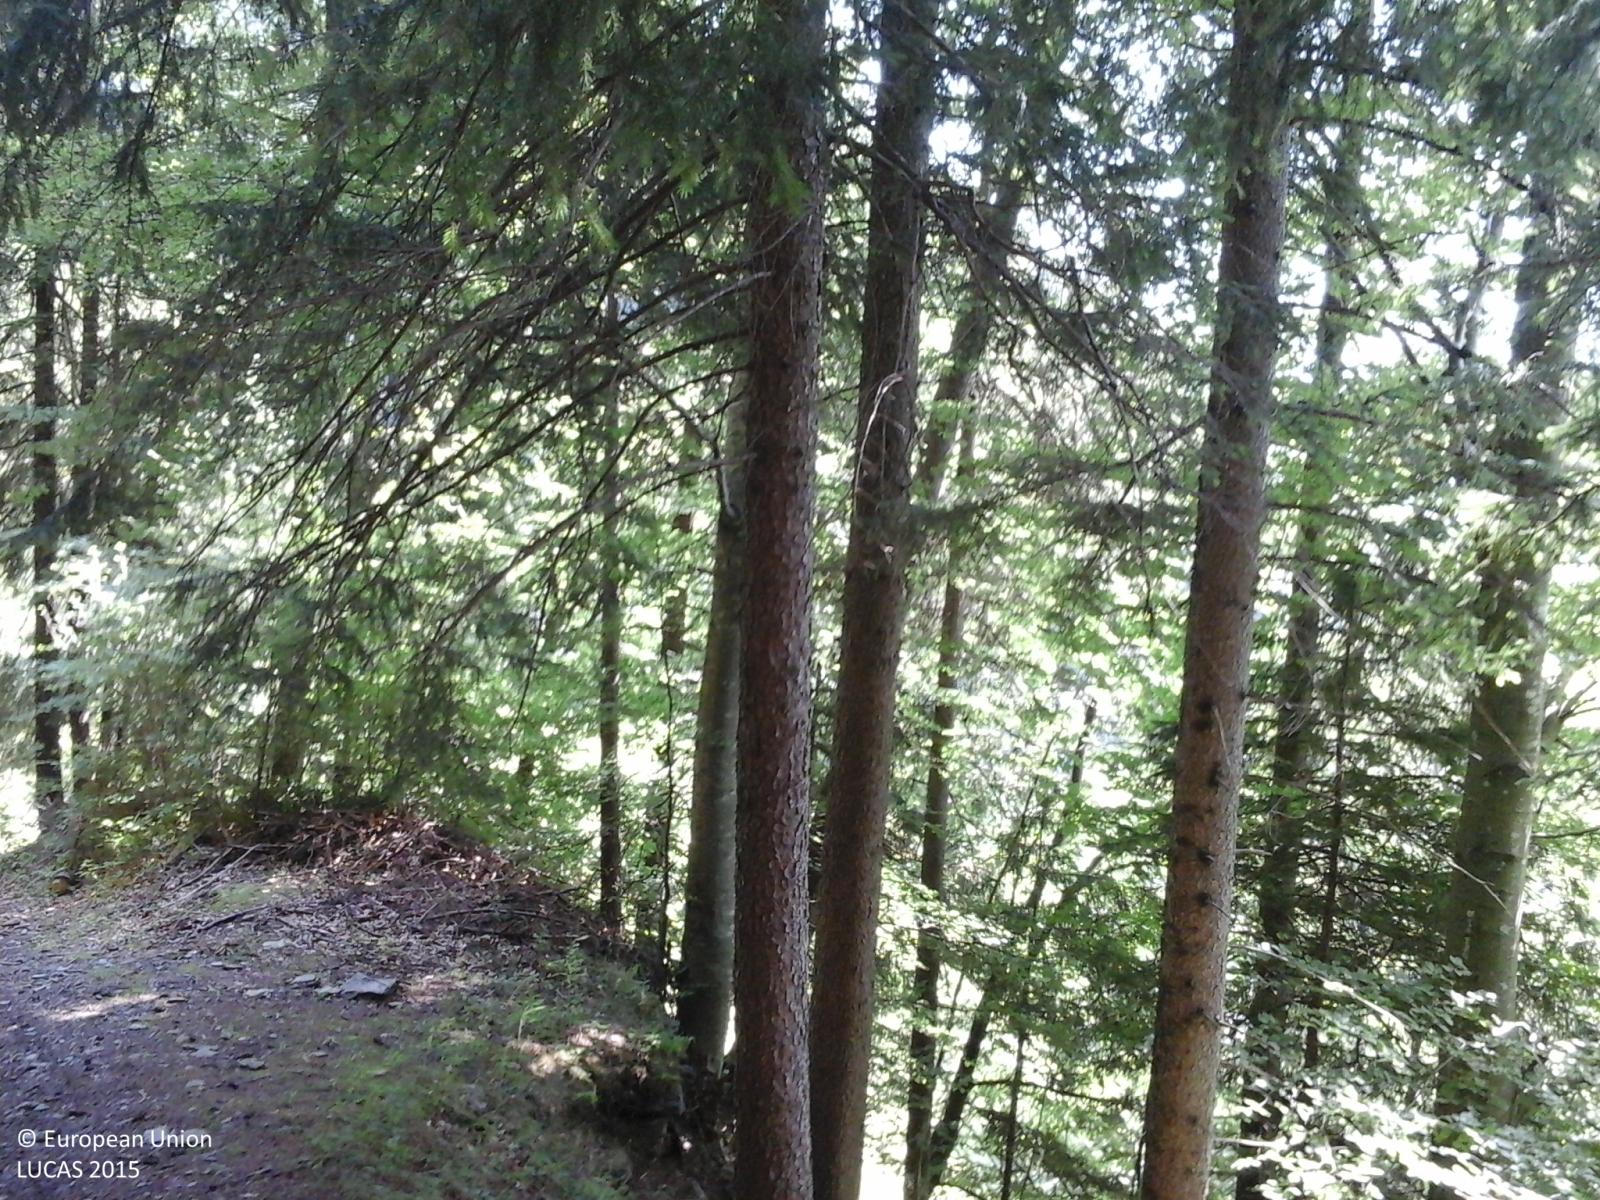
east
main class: Woodland
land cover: Spruce dominated coniferous woodland
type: alpine coniferous forest
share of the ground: > 75 %
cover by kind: coniferous forest trees 75 %, broadleaved forest trees 25 %
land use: Semi-natural and natural areas not in use
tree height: > 5 m
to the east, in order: Spruce dominated coniferous woodland; Tracks; Dry stone walls; Grassland without tree/shrub cover; Single bushes/trees; Grassland without tree/shrub cover; Spruce dominated mixed woodland; Tracks; Inland fresh running water; Broadleaved woodland
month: July
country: IT
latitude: 46.0089
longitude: 10.1161
